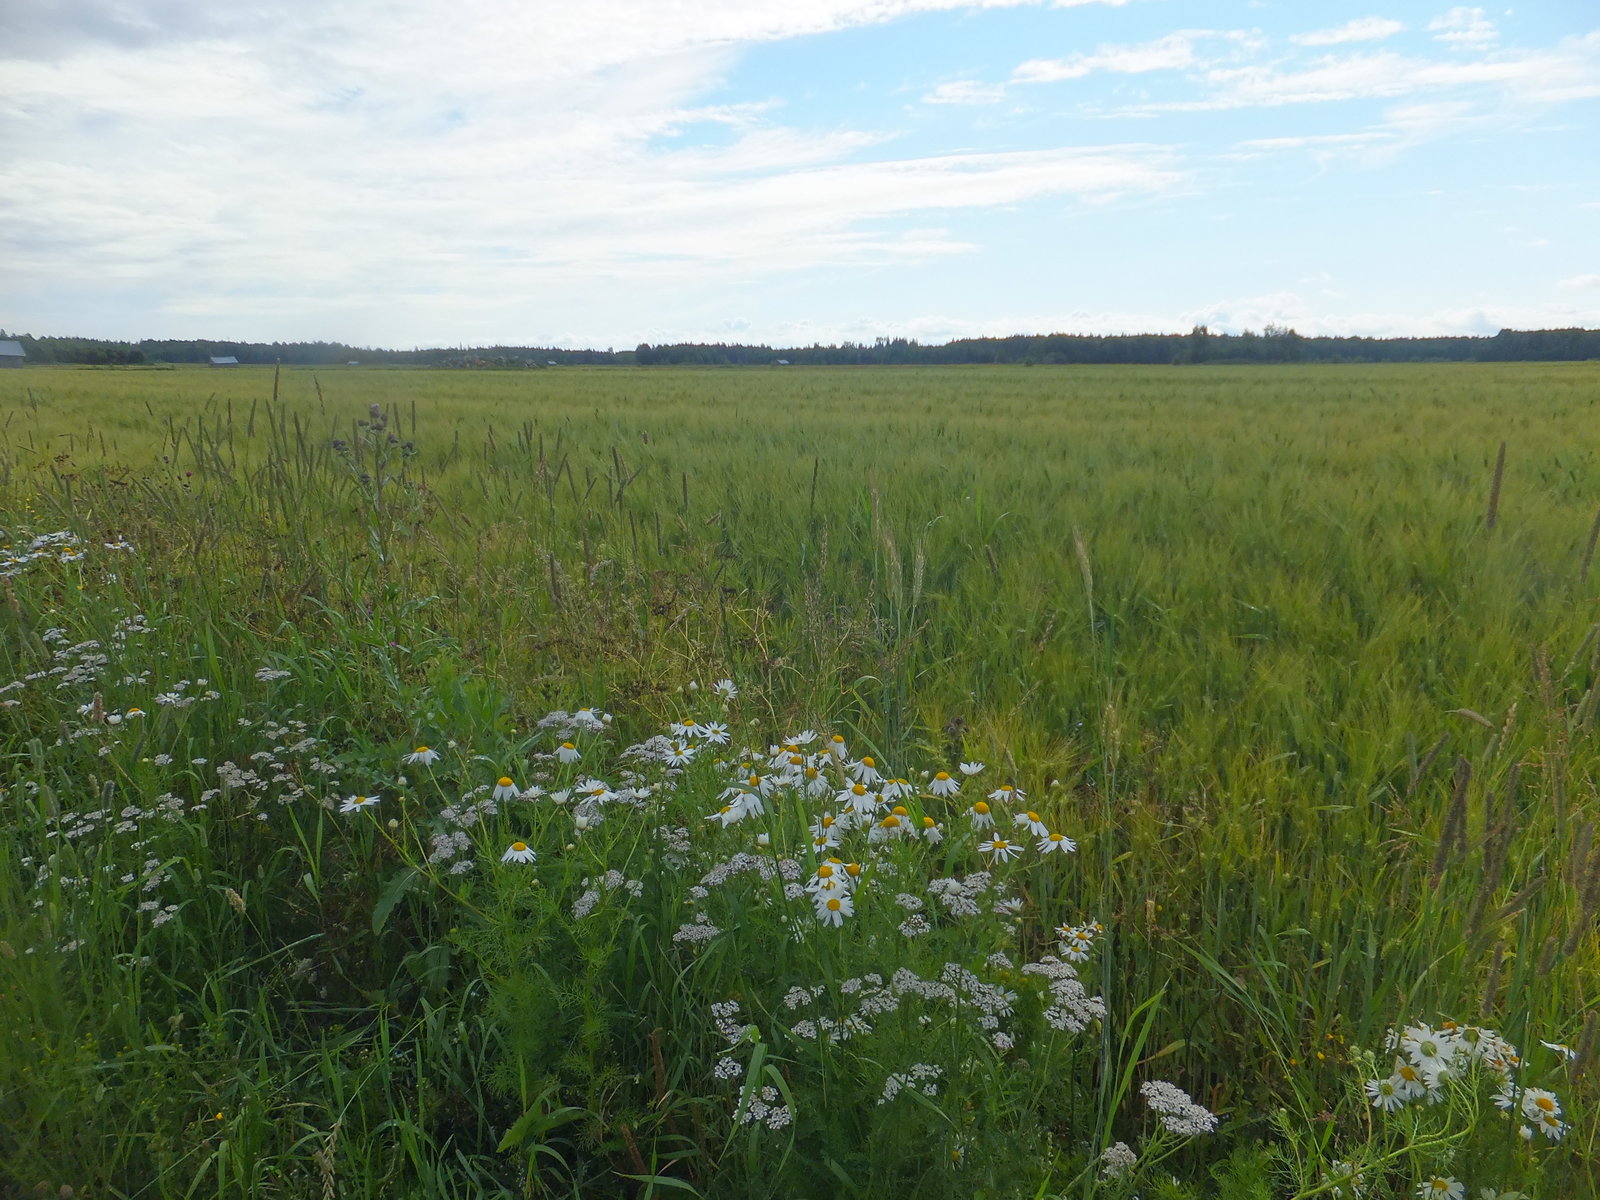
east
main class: Cropland
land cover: Barley
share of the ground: > 75 %
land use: Agriculture (excluding fallow land and kitchen gardens)
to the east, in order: Barley; Tracks; Grass margins; Ditches and canals; Barley
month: July
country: FI
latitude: 63.0409
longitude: 22.0466
